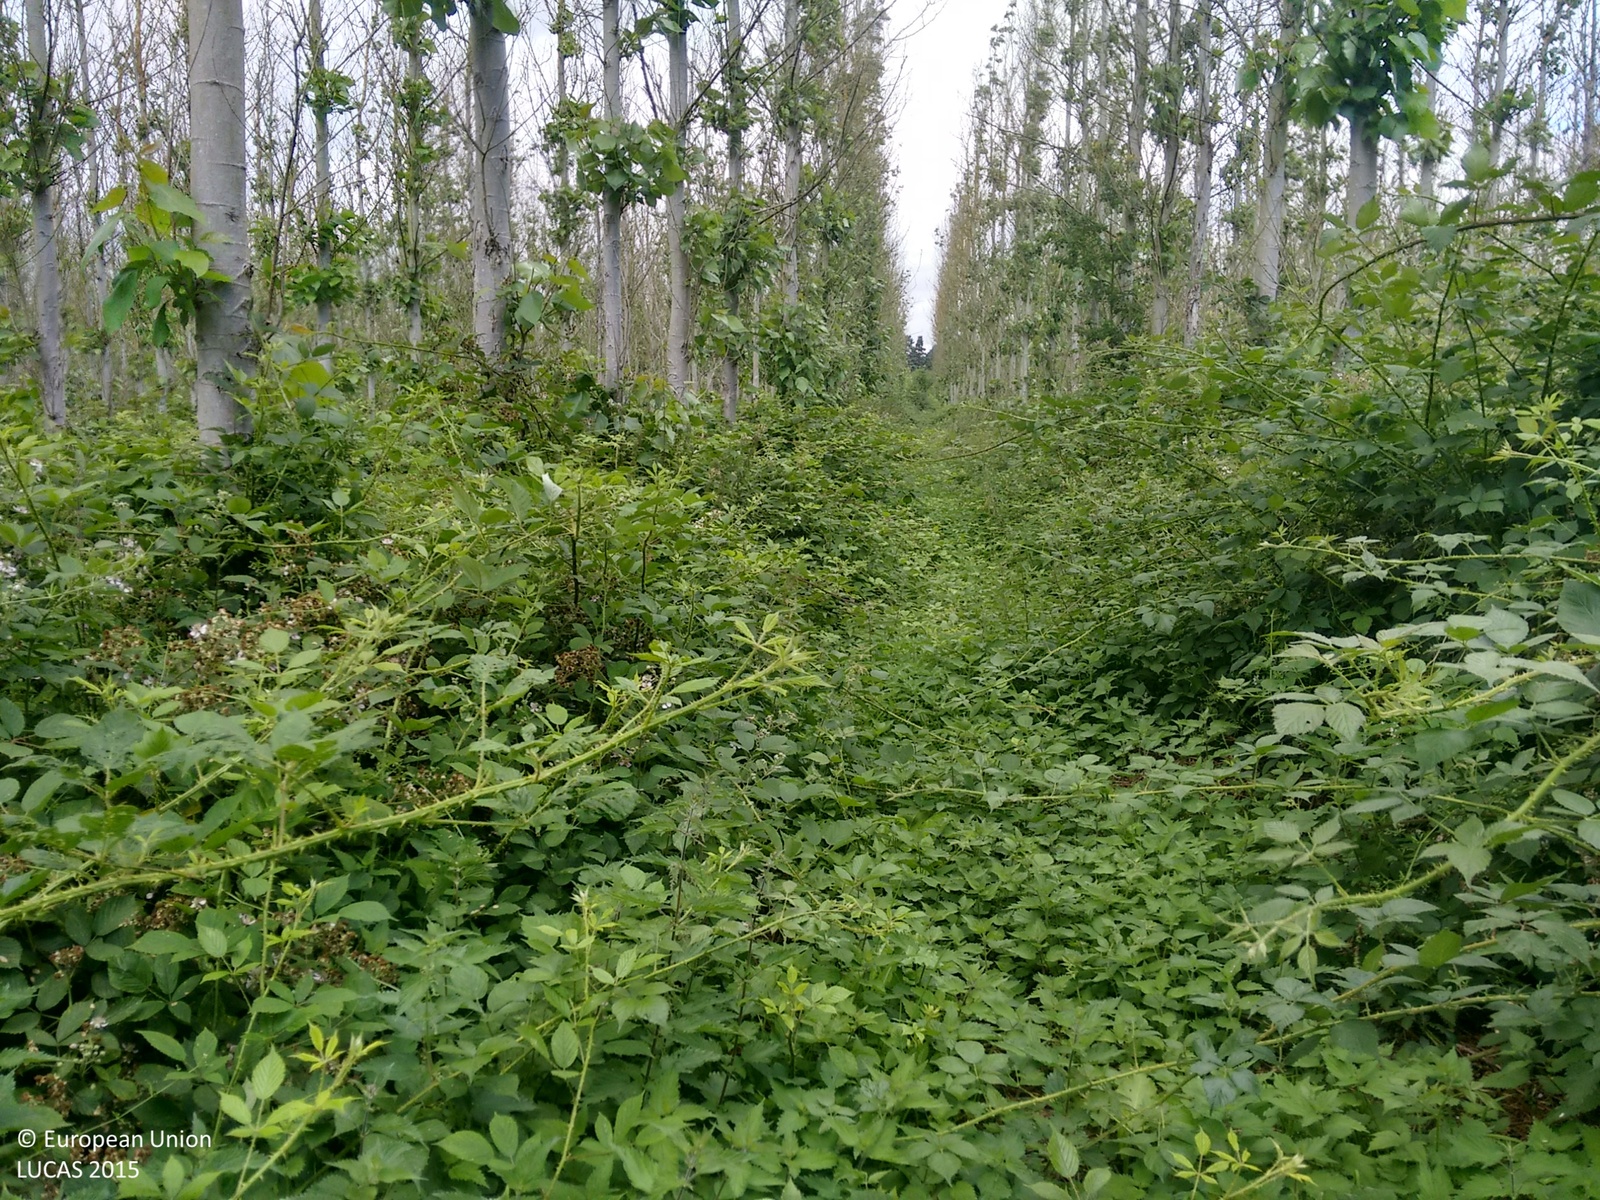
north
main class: Woodland
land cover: Broadleaved woodland
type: mesophytic deciduous forest
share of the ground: > 75 %
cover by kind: broadleaved forest trees 90 %, shrubs 10 %
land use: Forestry
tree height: > 5 m
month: July
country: GB
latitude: 52.6050
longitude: -1.7941
